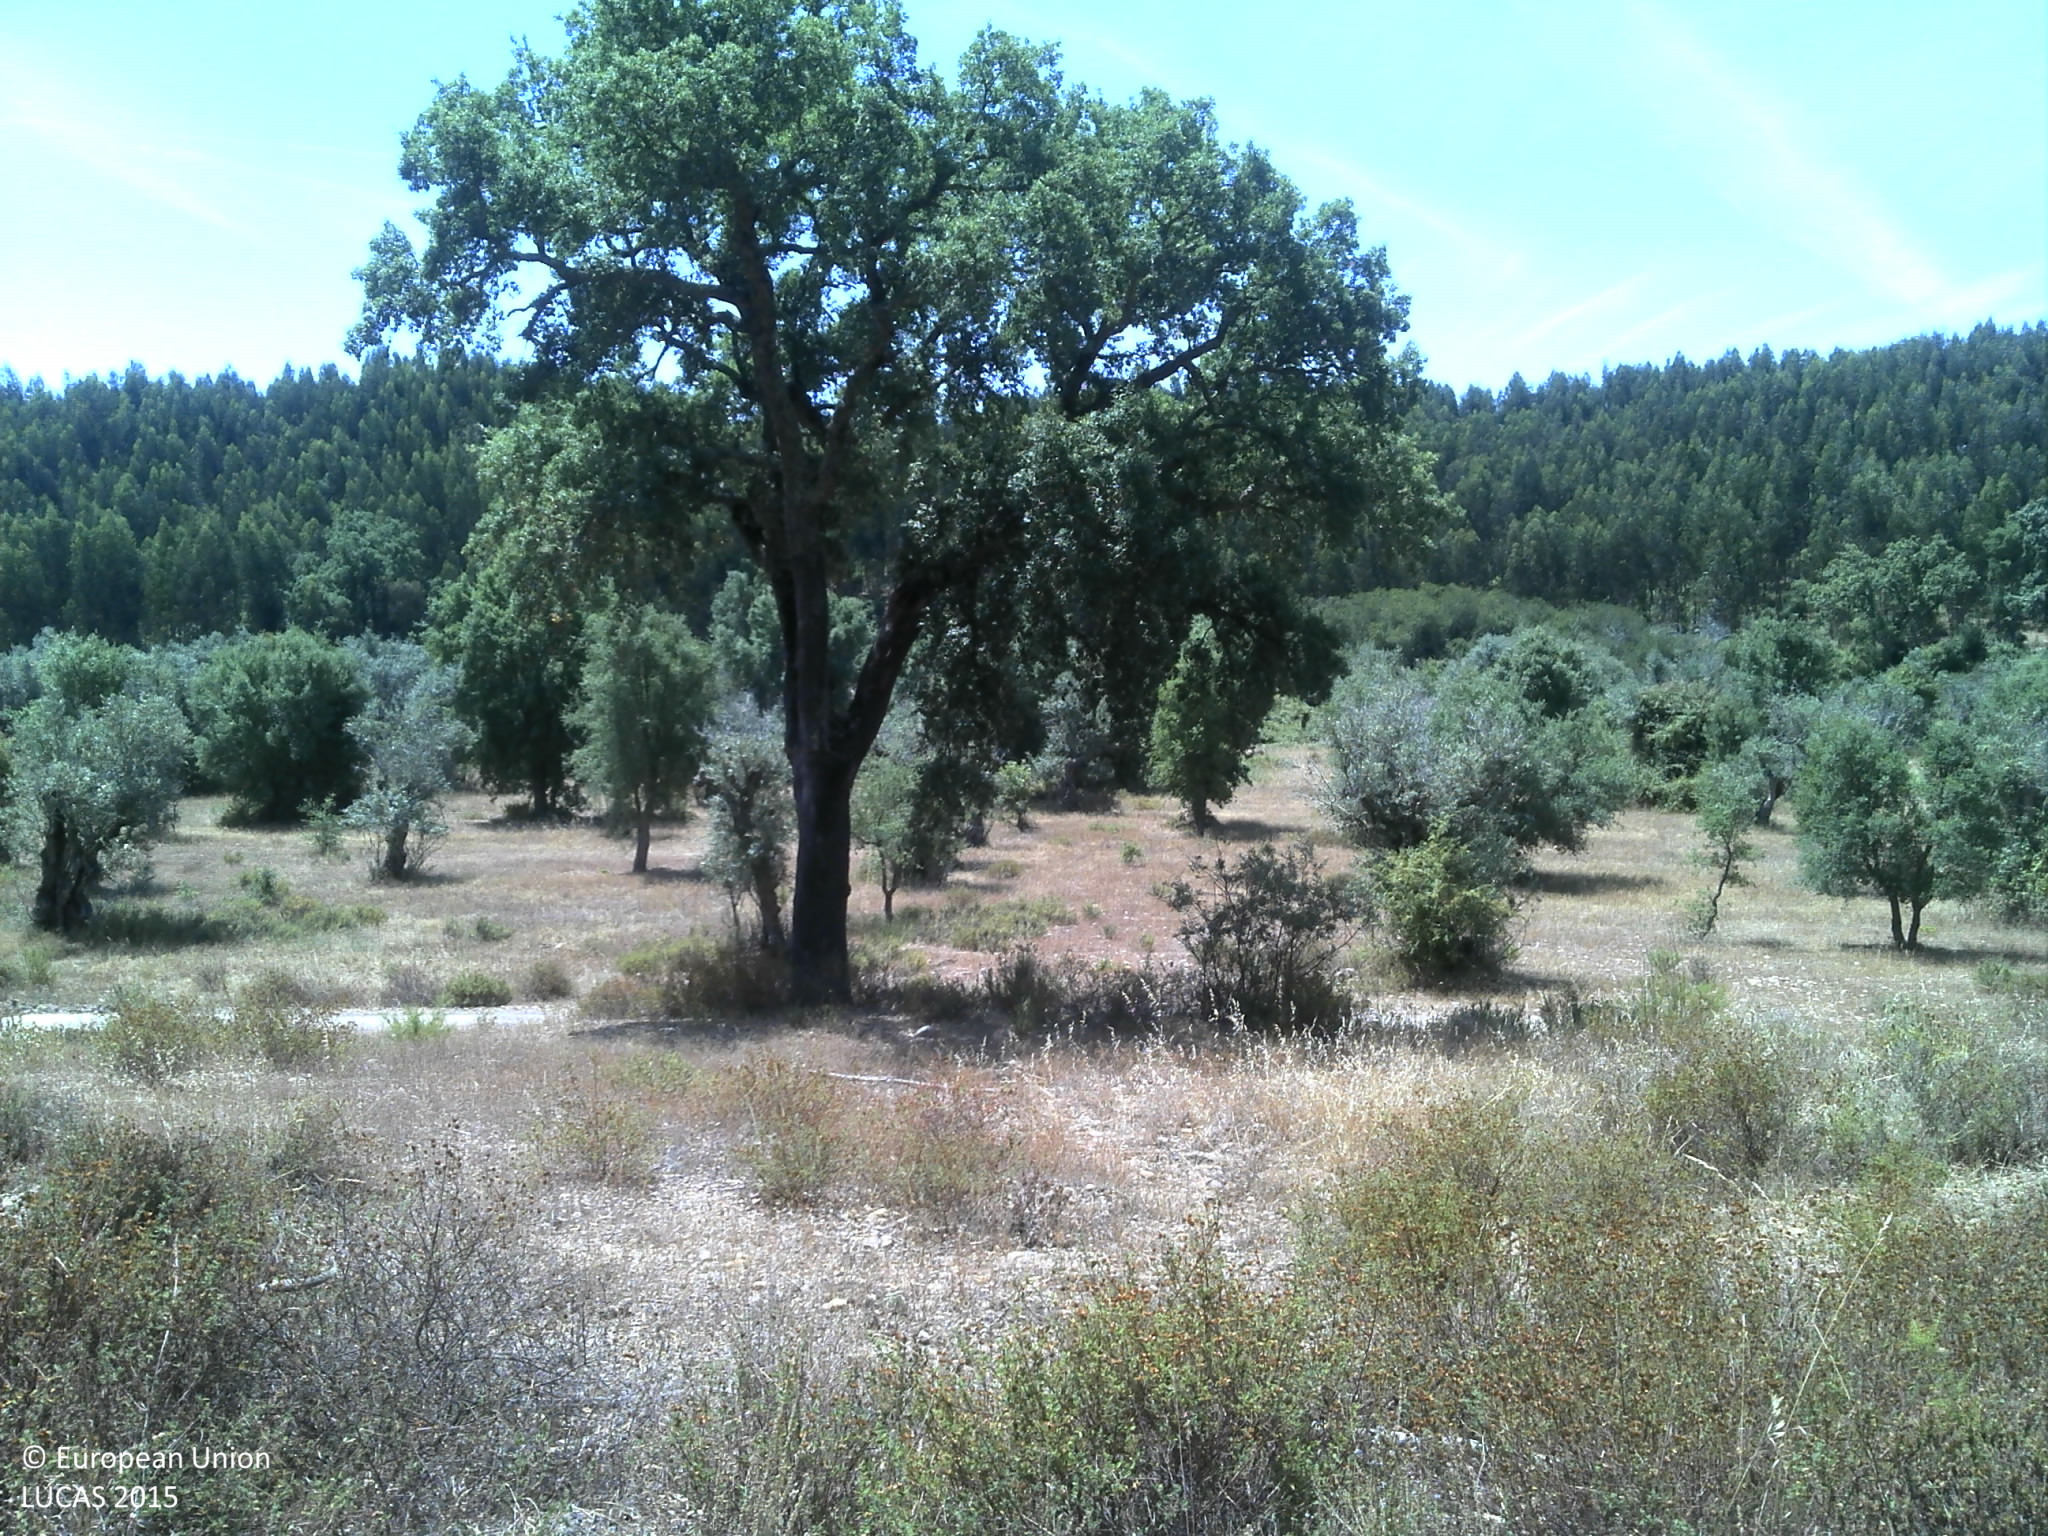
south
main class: Woodland
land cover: Broadleaved woodland
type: exotic forest
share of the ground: 25 - 50 %
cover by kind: broadleaved forest trees 45 %, unconsolidated bare surface 40 %, herbaceous plants 10 %, shrubs 5 %
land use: Forestry
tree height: > 5 m
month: July
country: PT
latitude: 39.3315
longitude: -8.2650
